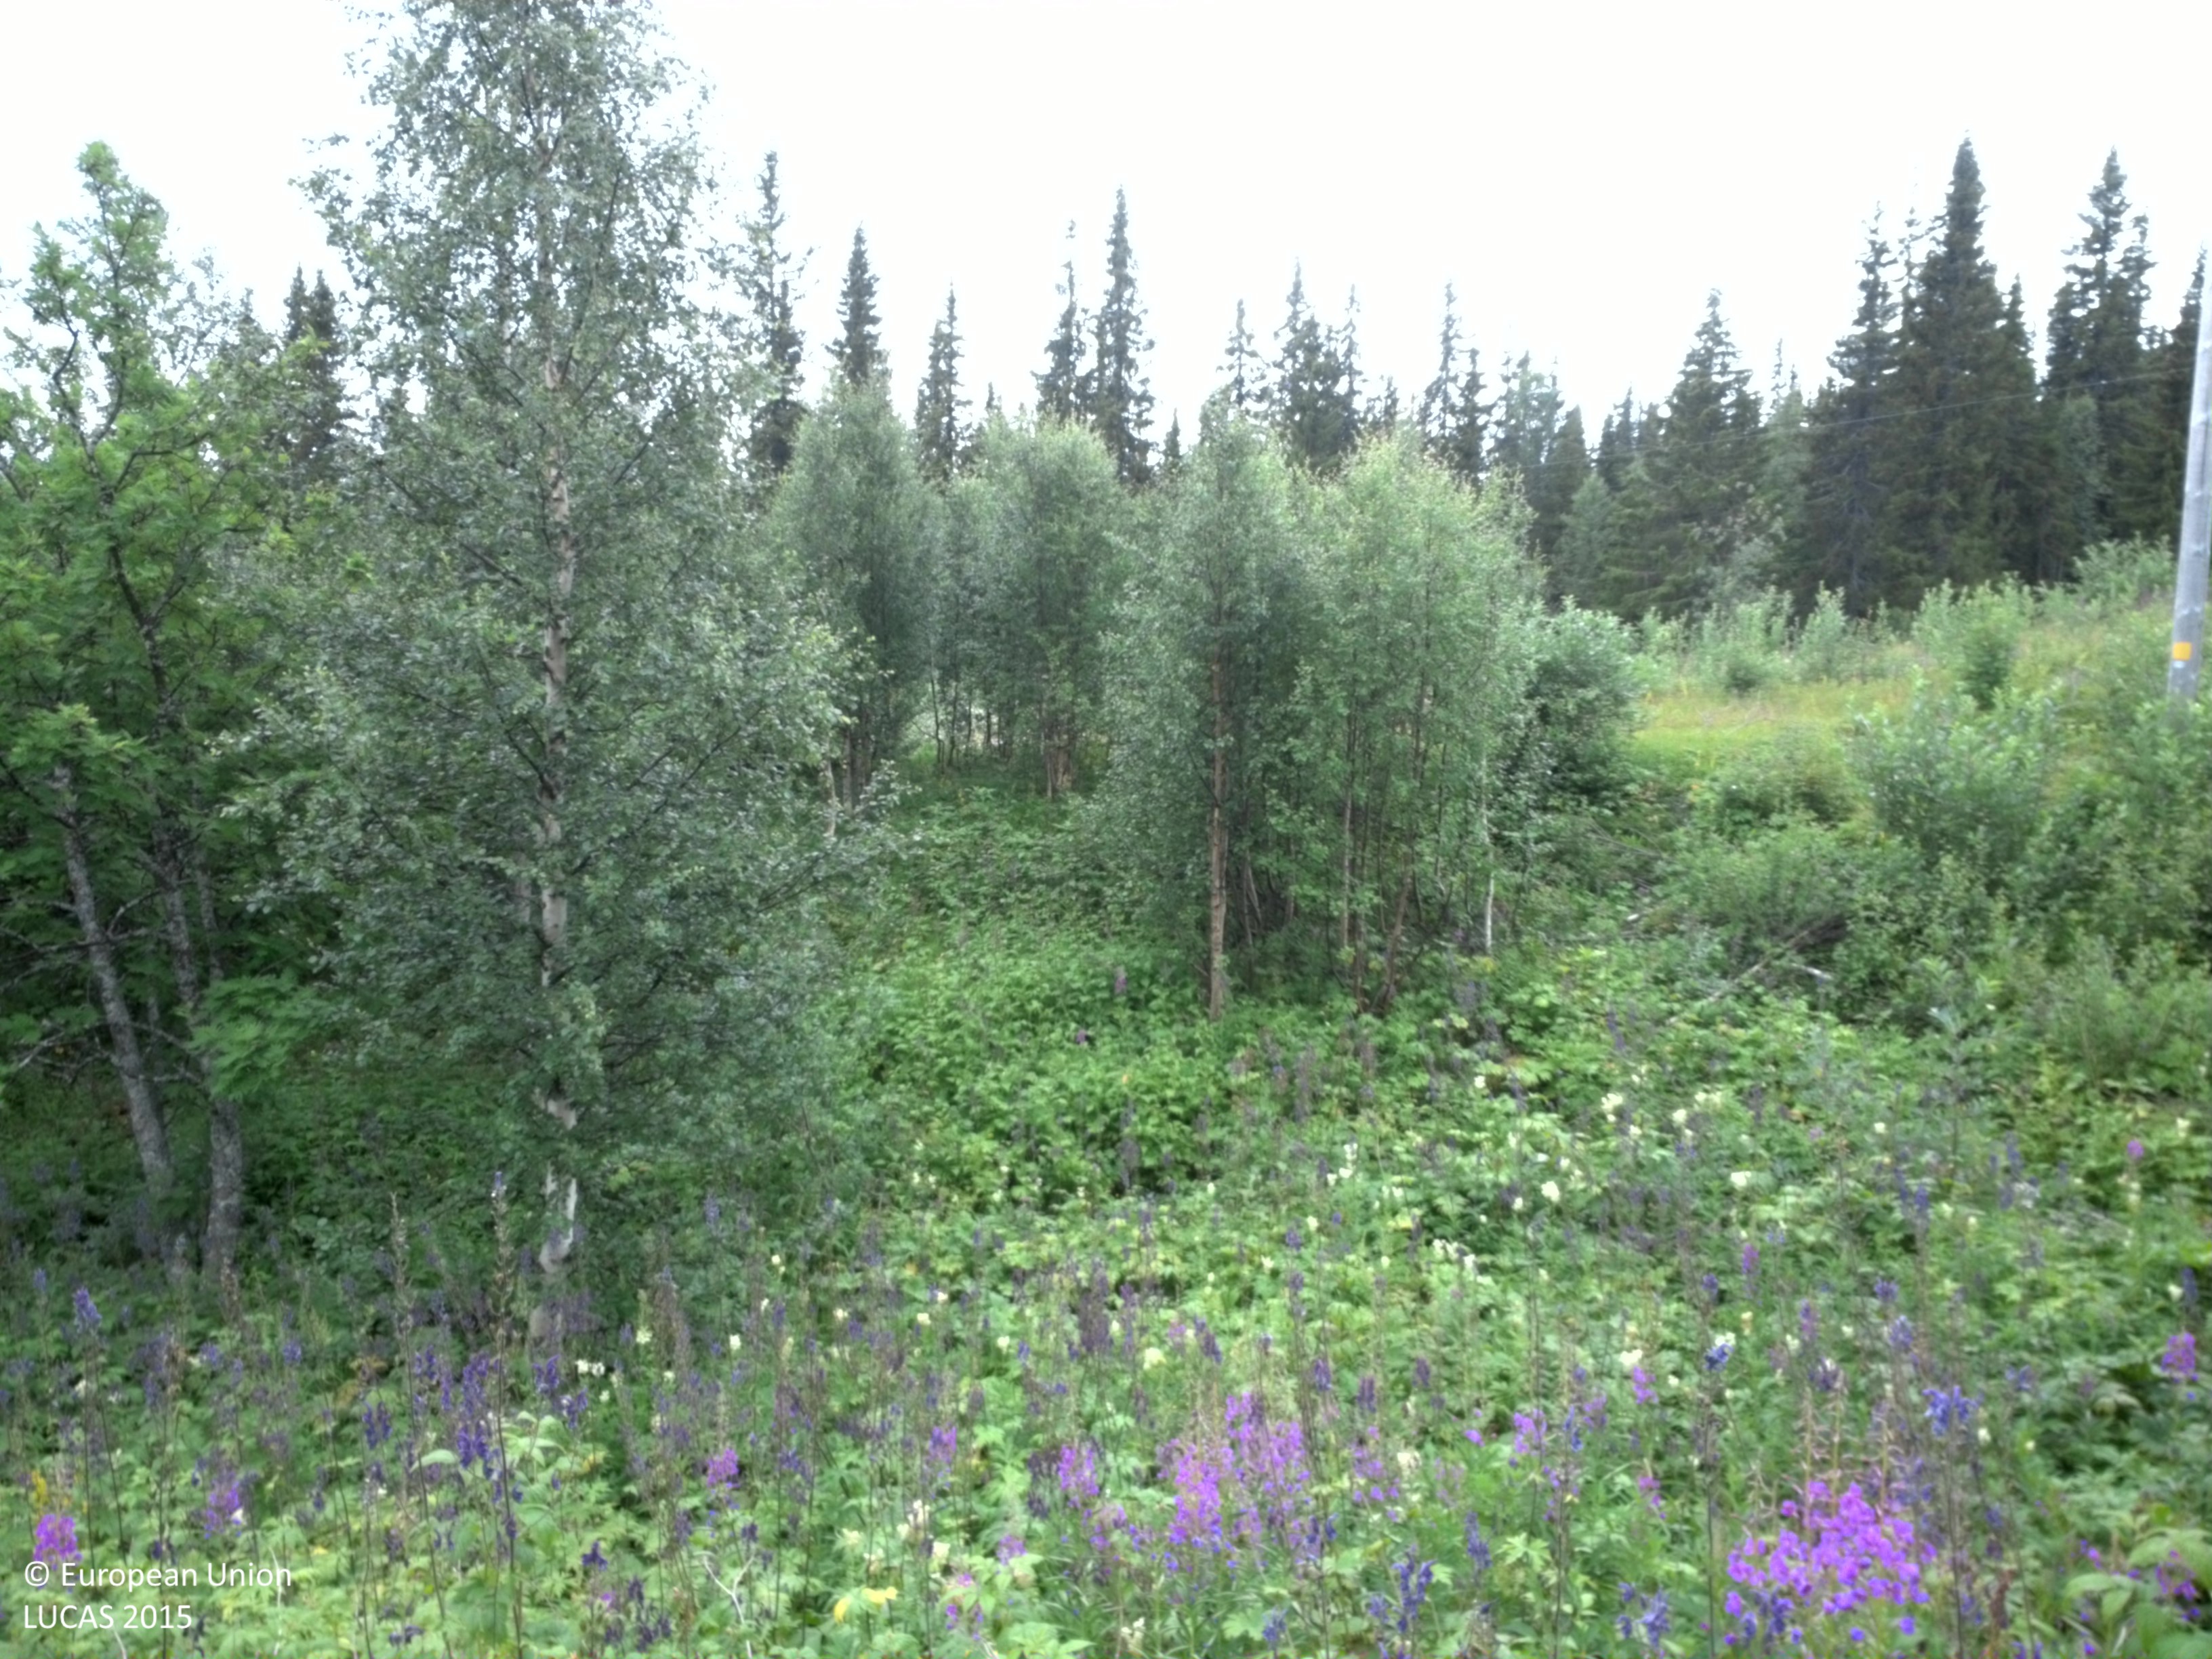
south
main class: Shrubland
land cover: Shrubland without tree cover
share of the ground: 10 - 25 %
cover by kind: herbaceous plants 85 %, shrubs 15 %
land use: Semi-natural and natural areas not in use
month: August
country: SE
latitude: 64.9312
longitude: 15.6572
